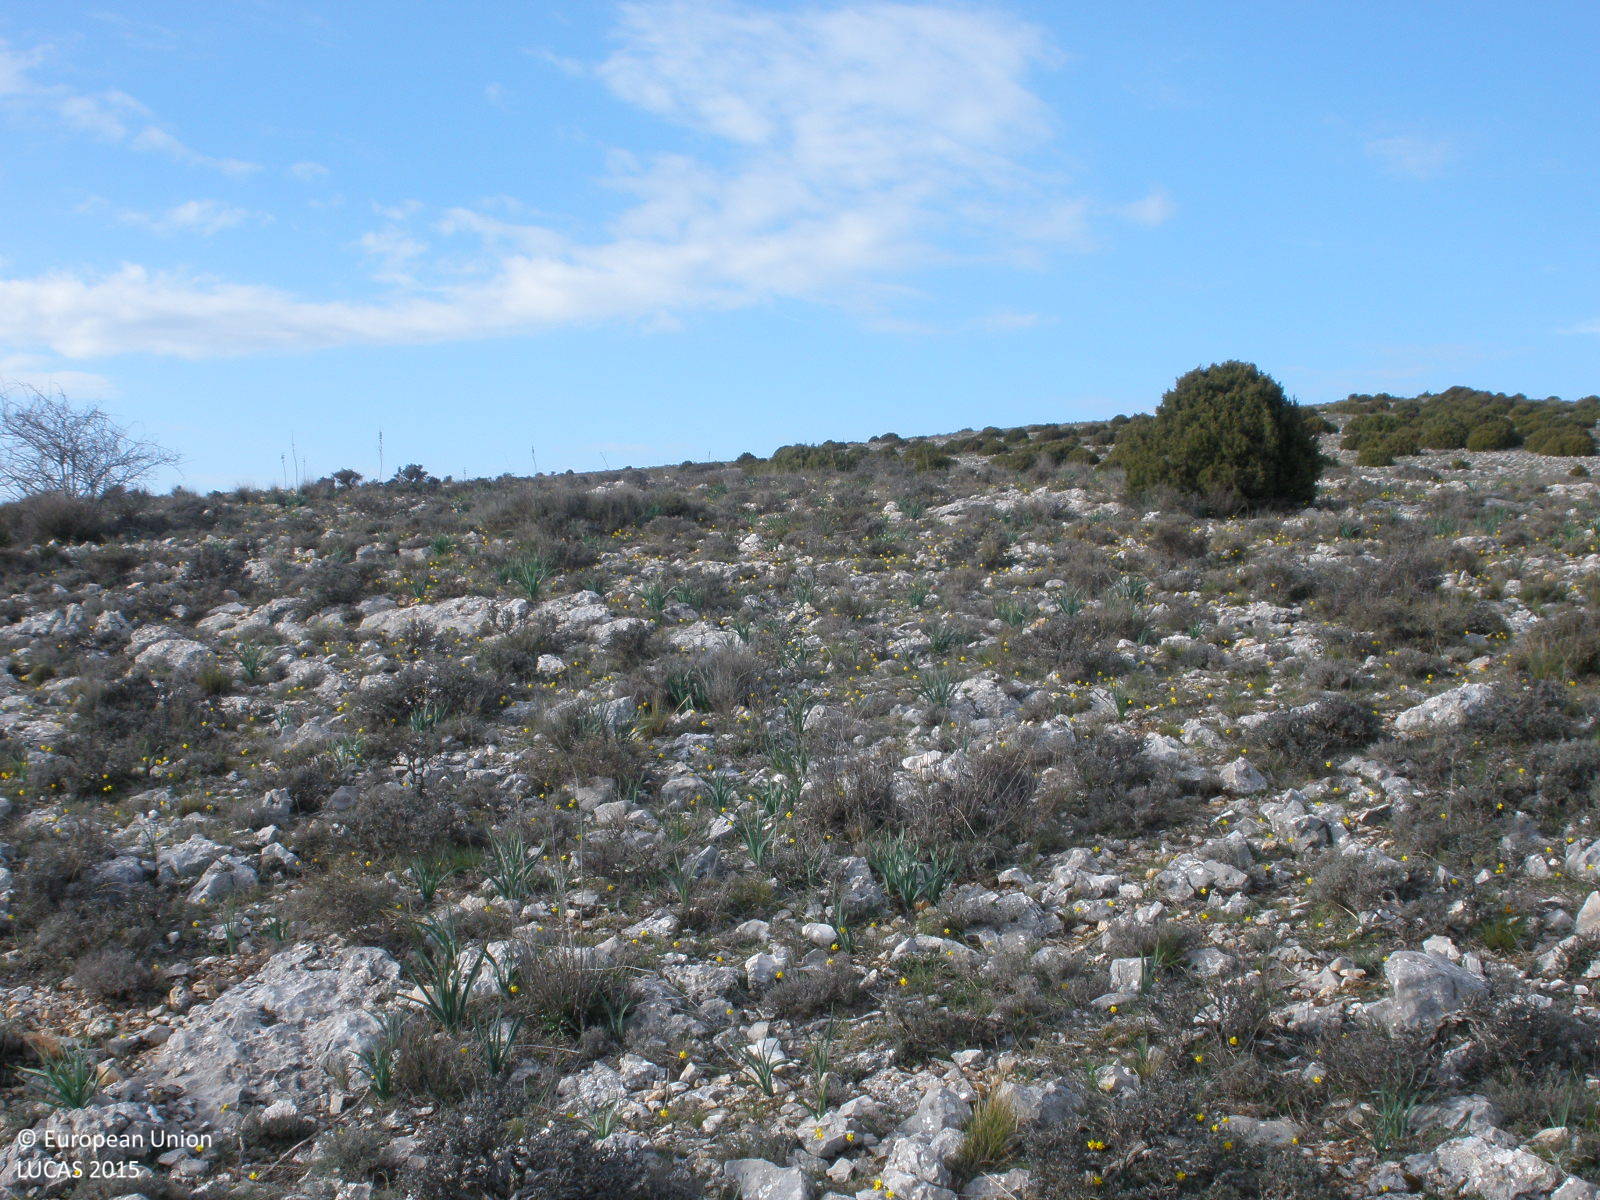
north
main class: Woodland
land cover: Other coniferous woodland
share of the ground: 10 - 25 %
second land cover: Grassland without tree/shrub cover
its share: 10 - 25 %
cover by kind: shrubs 30 %, herbaceous plants 30 %, coniferous forest trees 20 %, consolidated bare surface 10 %, unconsolidated bare surface 10 %
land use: Forestry
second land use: Agriculture (excluding fallow land and kitchen gardens)
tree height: < 5 m
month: April
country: ES
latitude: 41.0506
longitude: -1.1663
